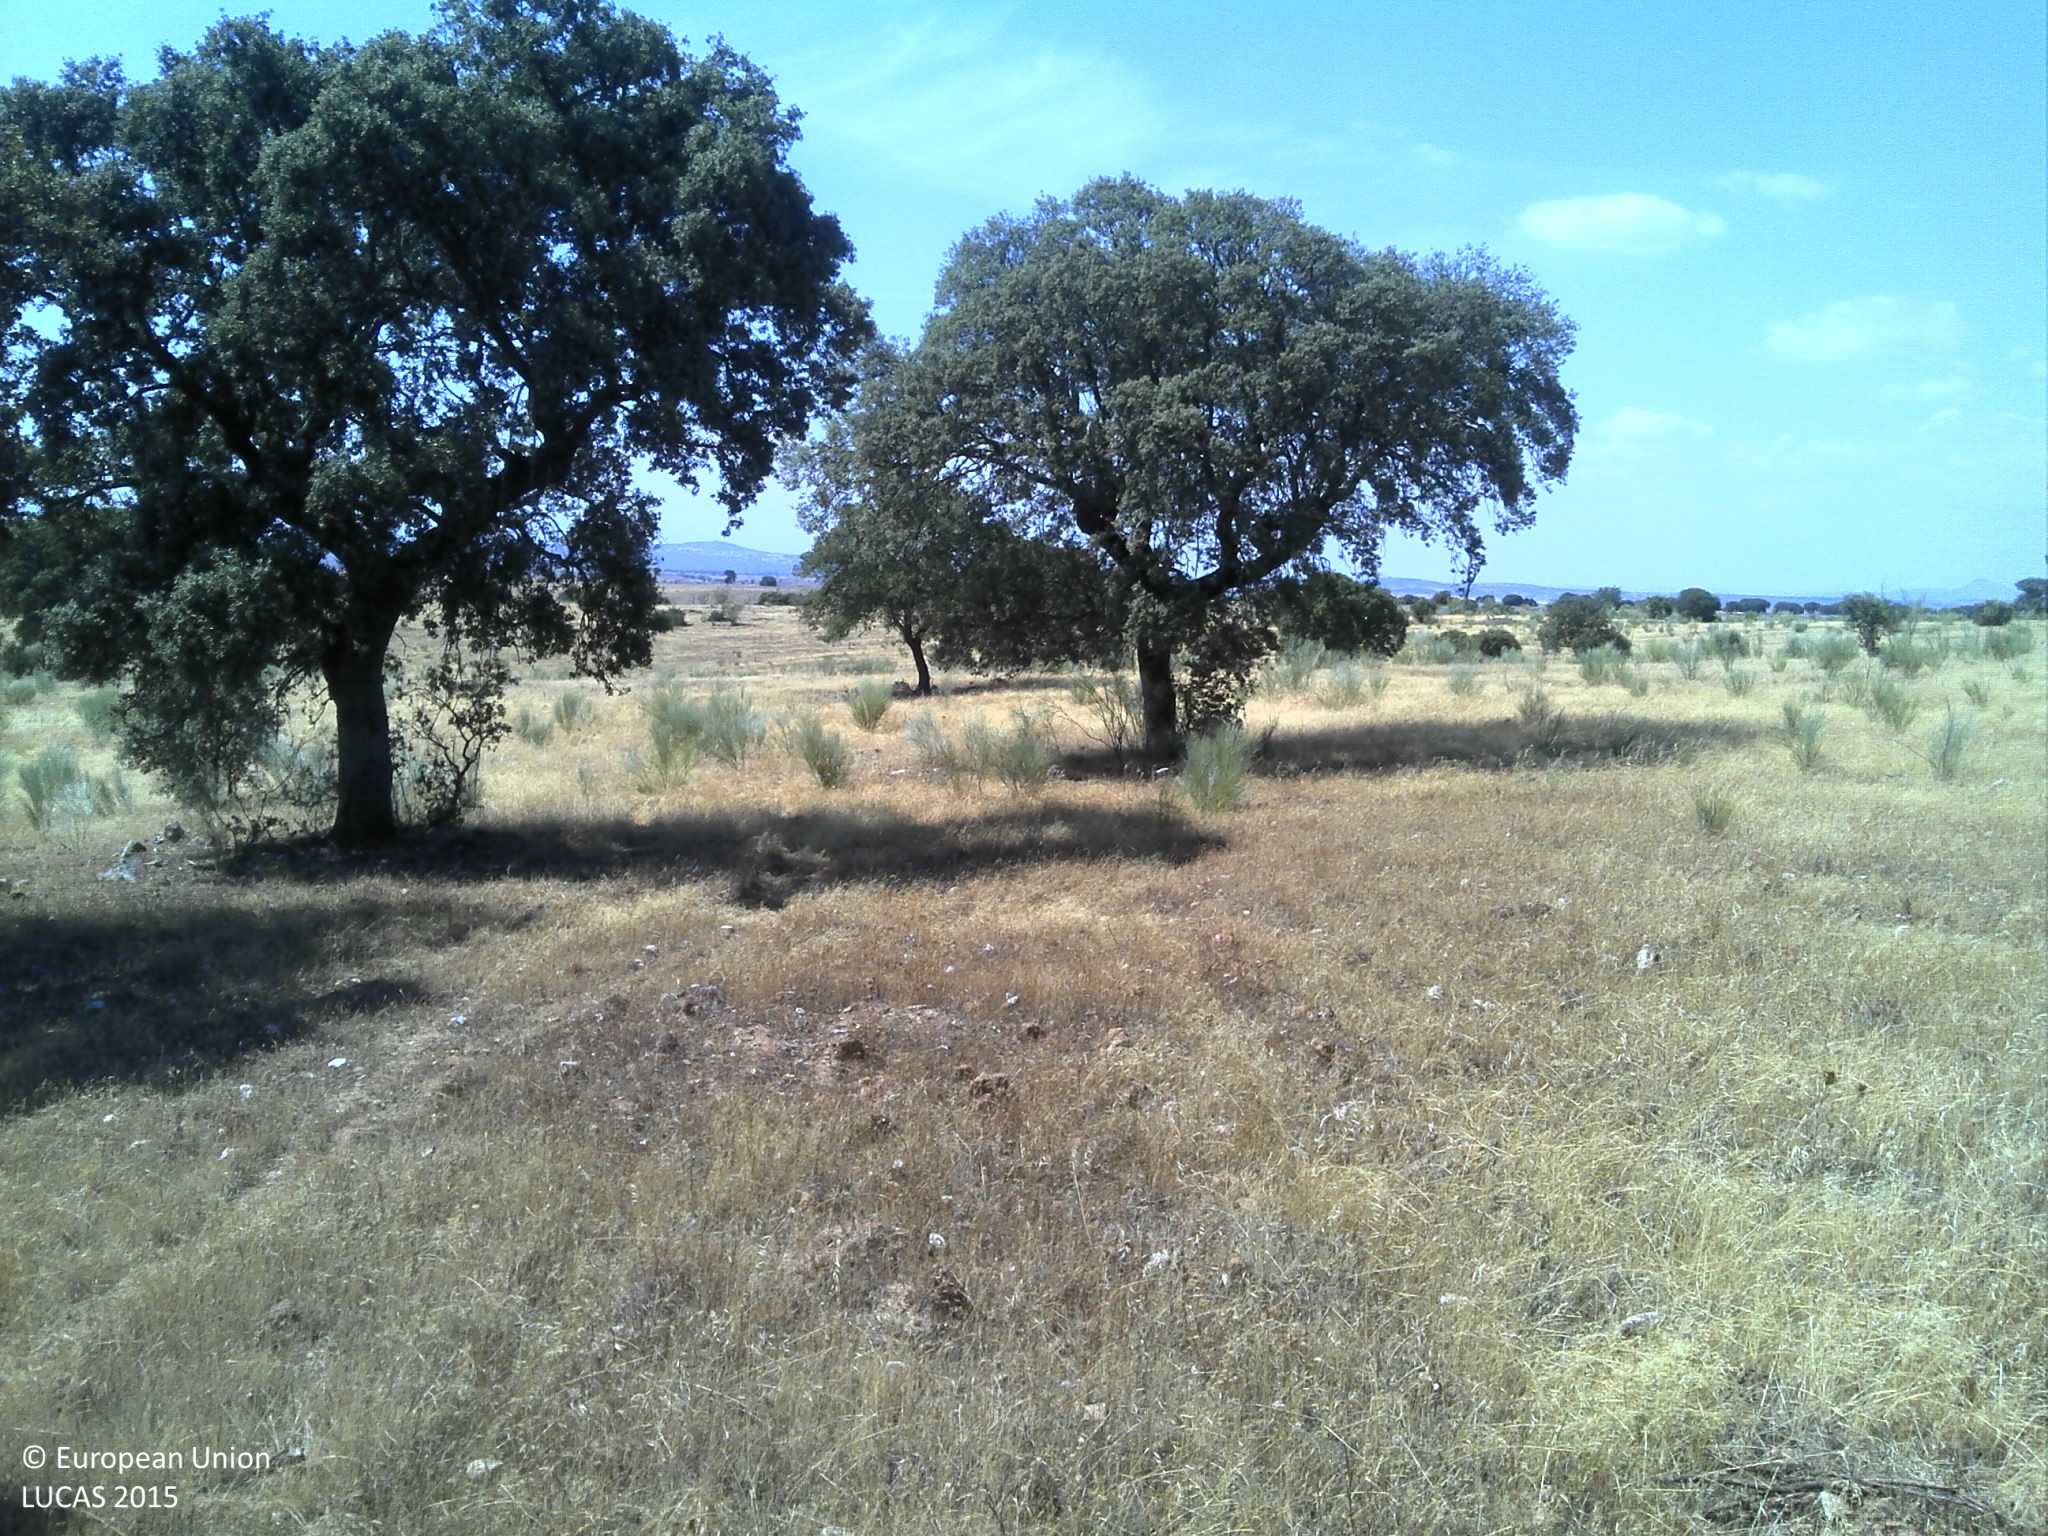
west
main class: Woodland
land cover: Broadleaved woodland
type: broadleaved evergreen forest
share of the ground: 25 - 50 %
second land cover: Grassland without tree/shrub cover
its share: 25 - 50 %
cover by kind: broadleaved forest trees 35 %, herbaceous plants 35 %, unconsolidated bare surface 20 %, shrubs 5 %
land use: Forestry
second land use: Agriculture (excluding fallow land and kitchen gardens)
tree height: > 5 m
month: June
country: PT
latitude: 39.7954
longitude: -7.1527
